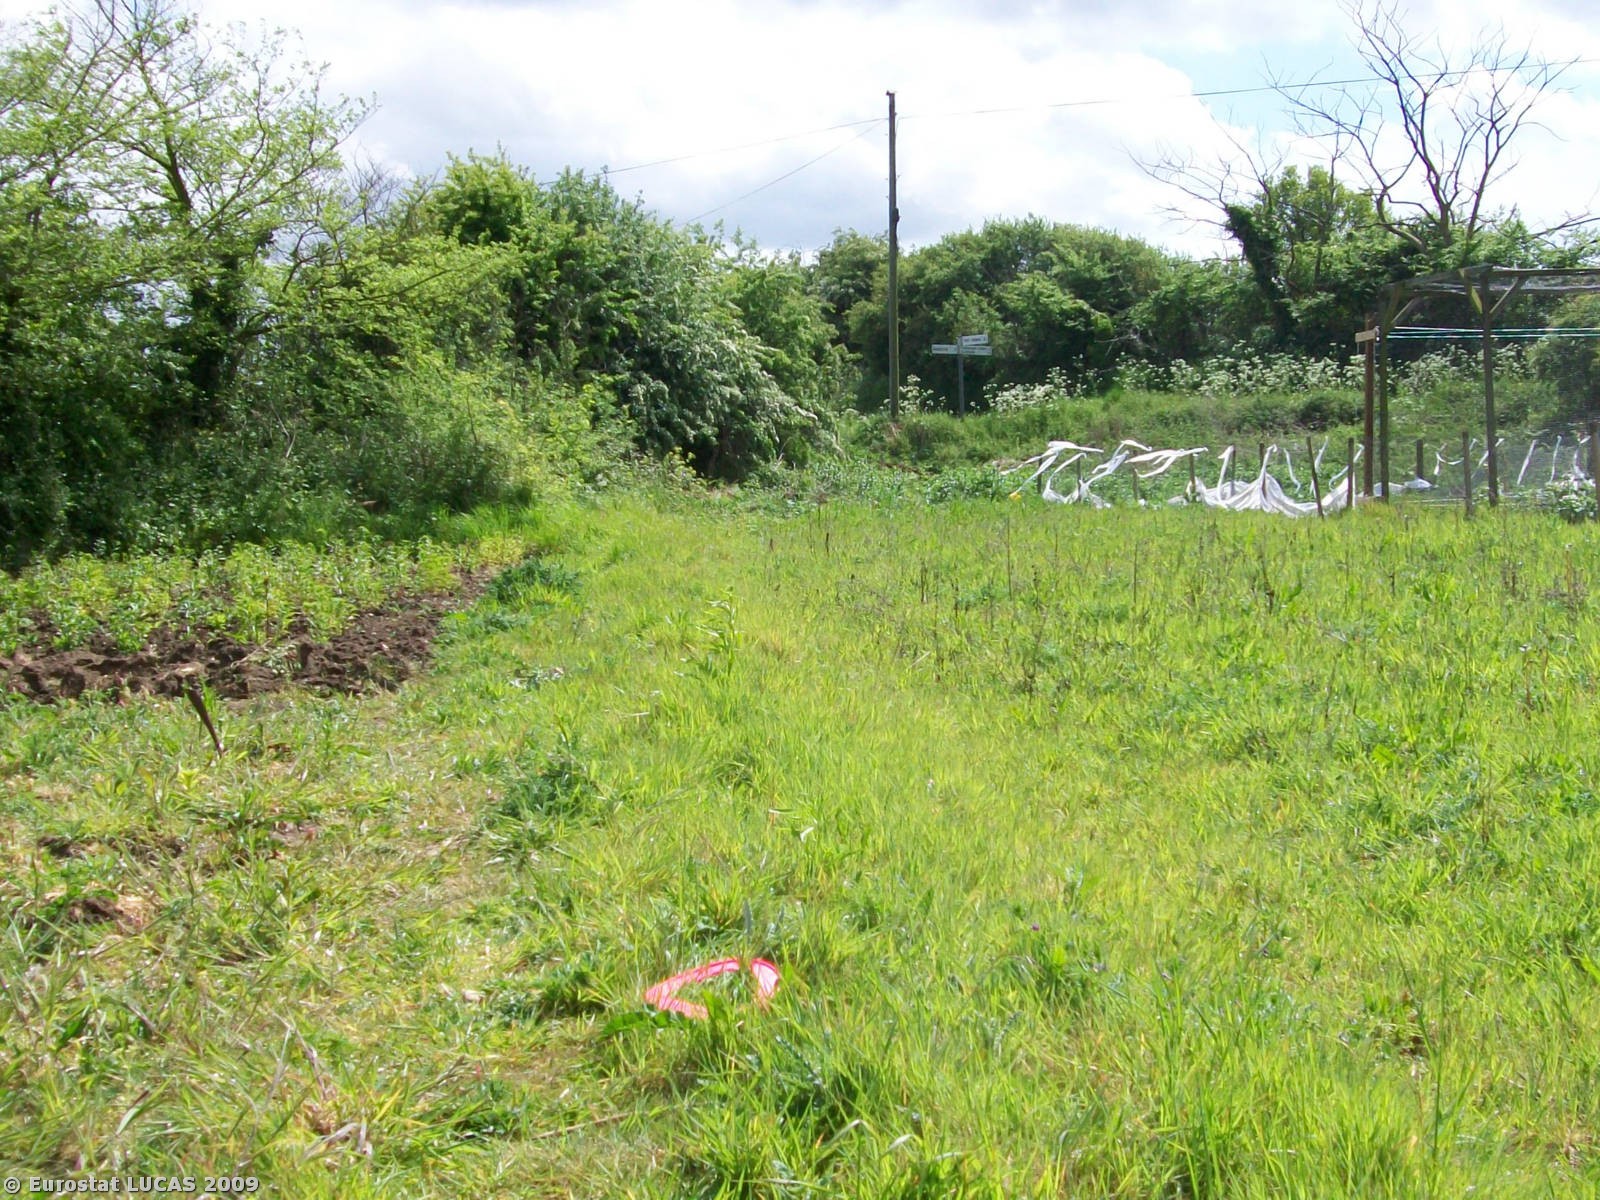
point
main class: Grassland
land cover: Grassland without tree/shrub cover
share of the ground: > 75 %
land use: Fallow land
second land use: Amenities, museums, leisure
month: May
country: GB
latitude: 52.5288
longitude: 1.5646
